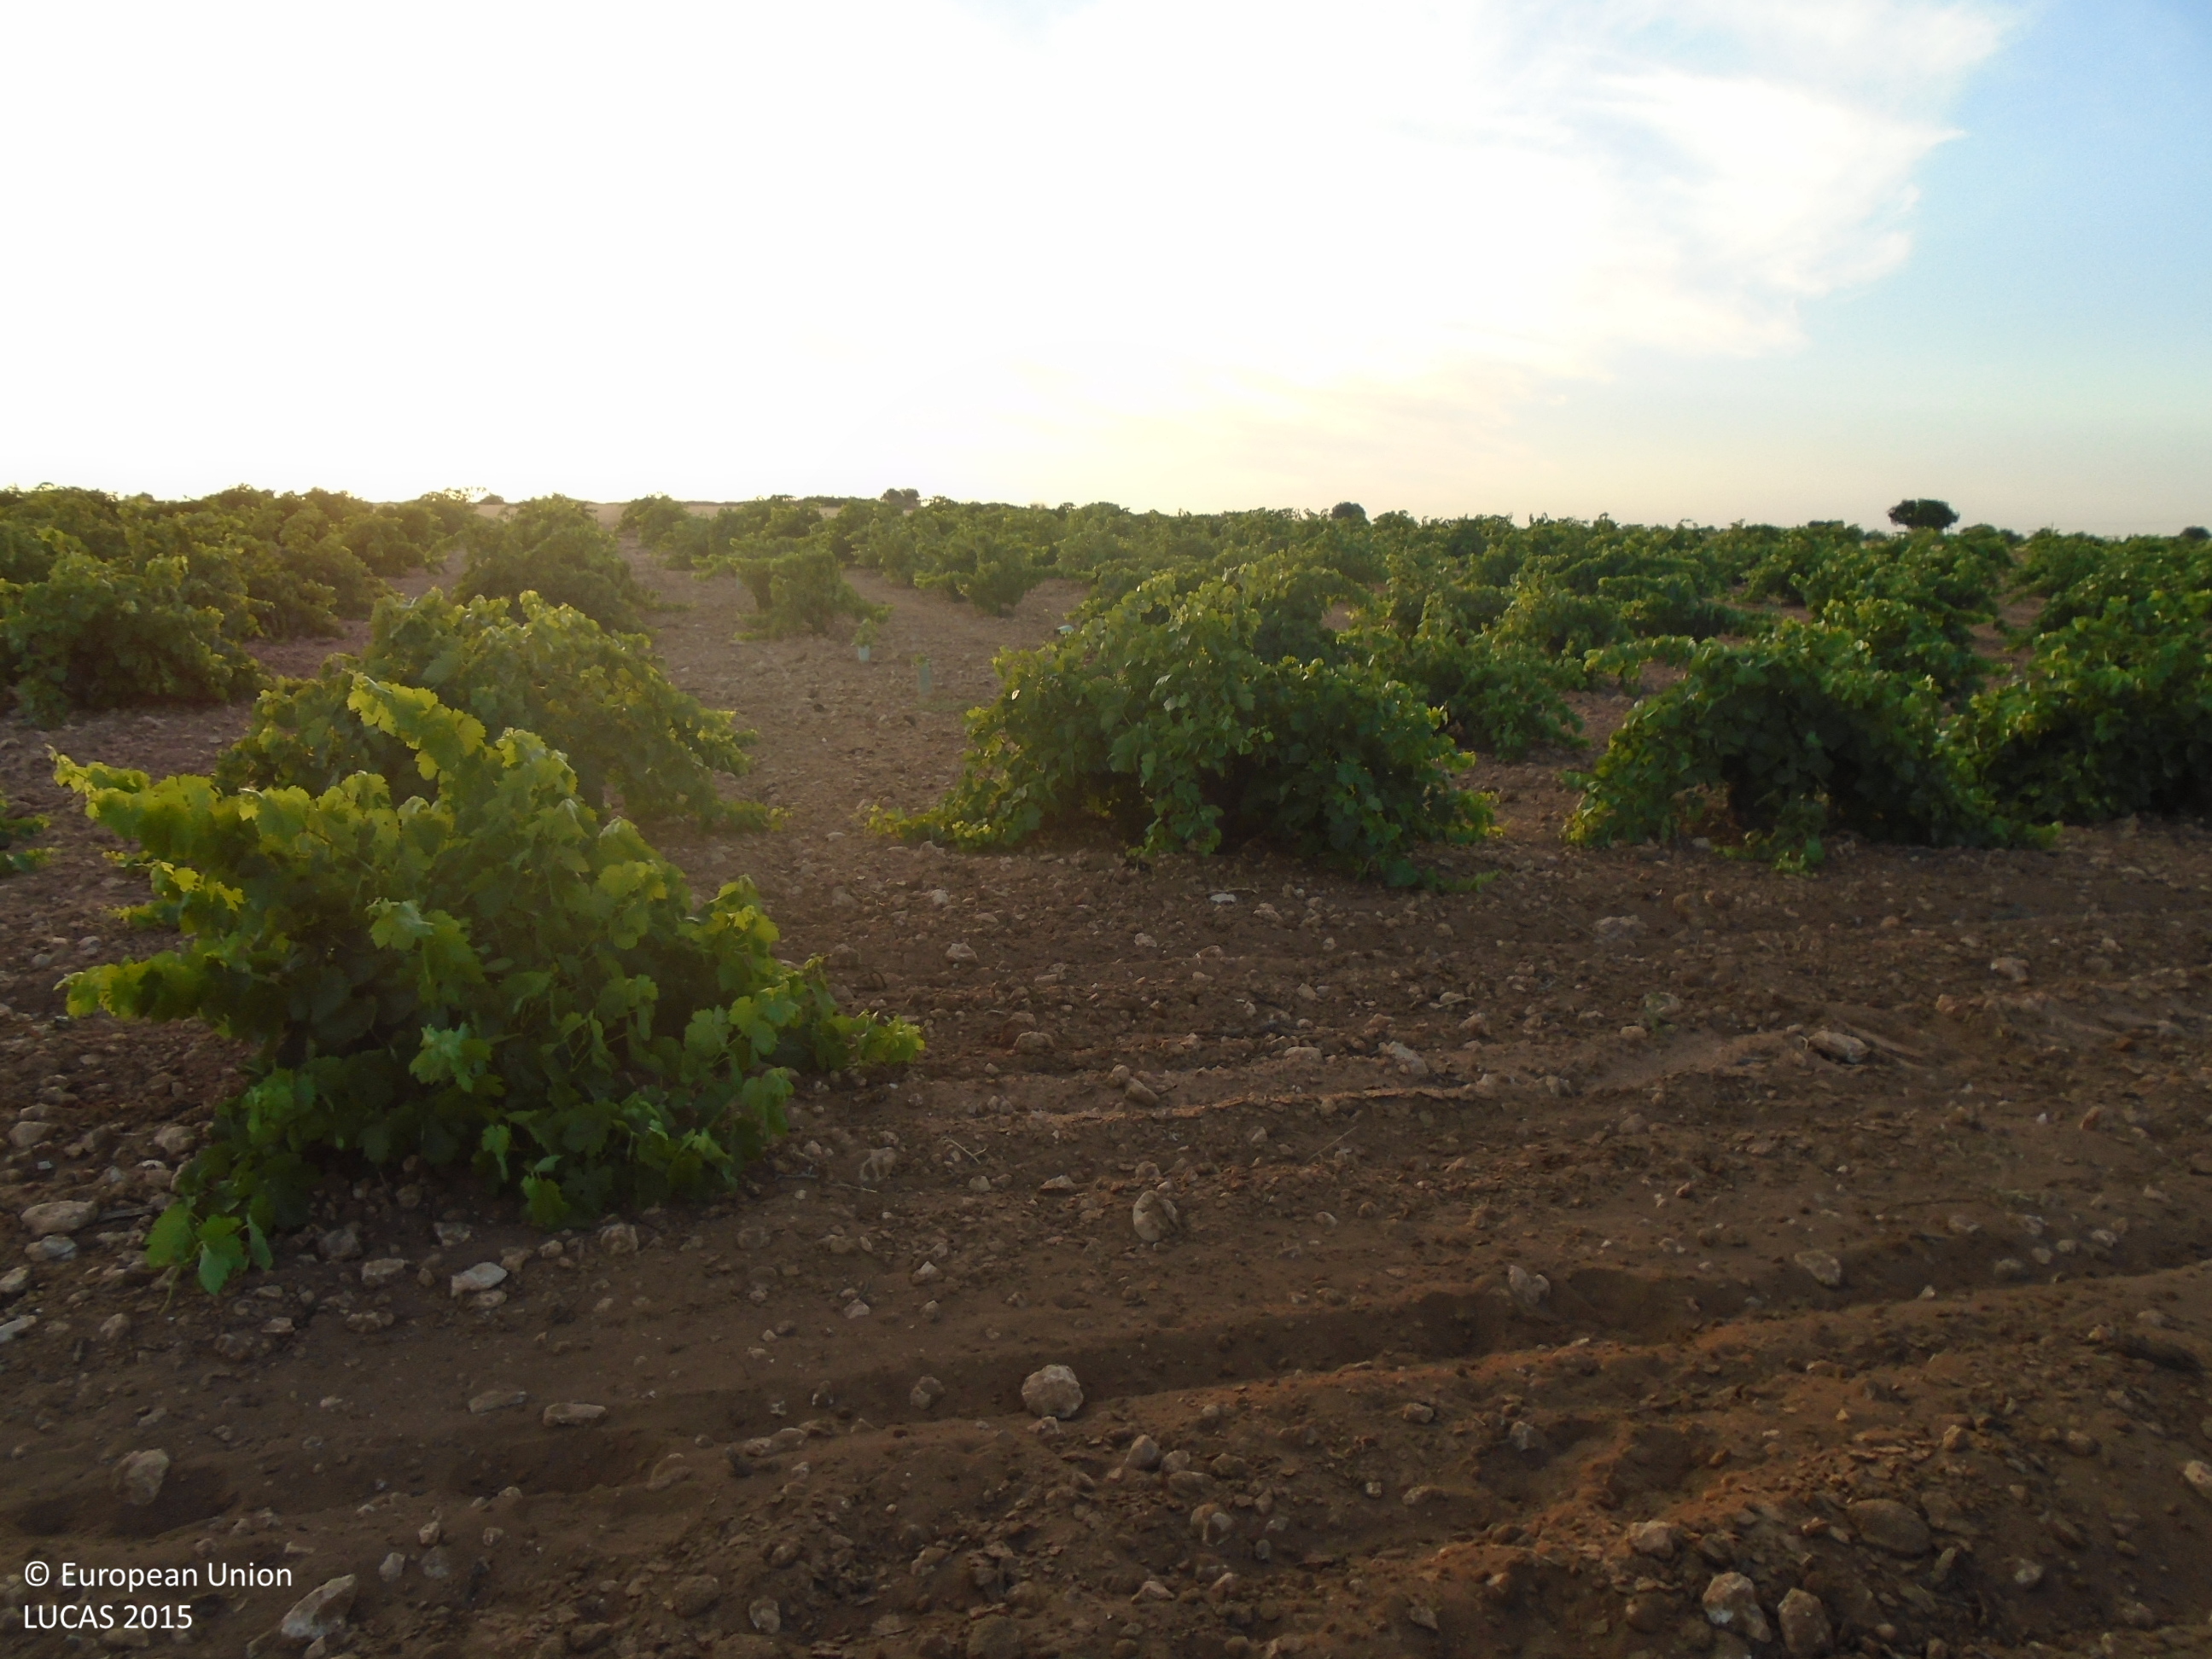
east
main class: Cropland
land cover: Vineyards
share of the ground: 50 - 75 %
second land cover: Other bare soil
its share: > 75 %
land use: Agriculture (excluding fallow land and kitchen gardens)
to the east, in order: Vineyards; Other bare soil; Grass margins; Barley; Grass margins; Other bare soil; Grass margins; Vineyards
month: June
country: ES
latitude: 39.2001
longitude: -3.5085
